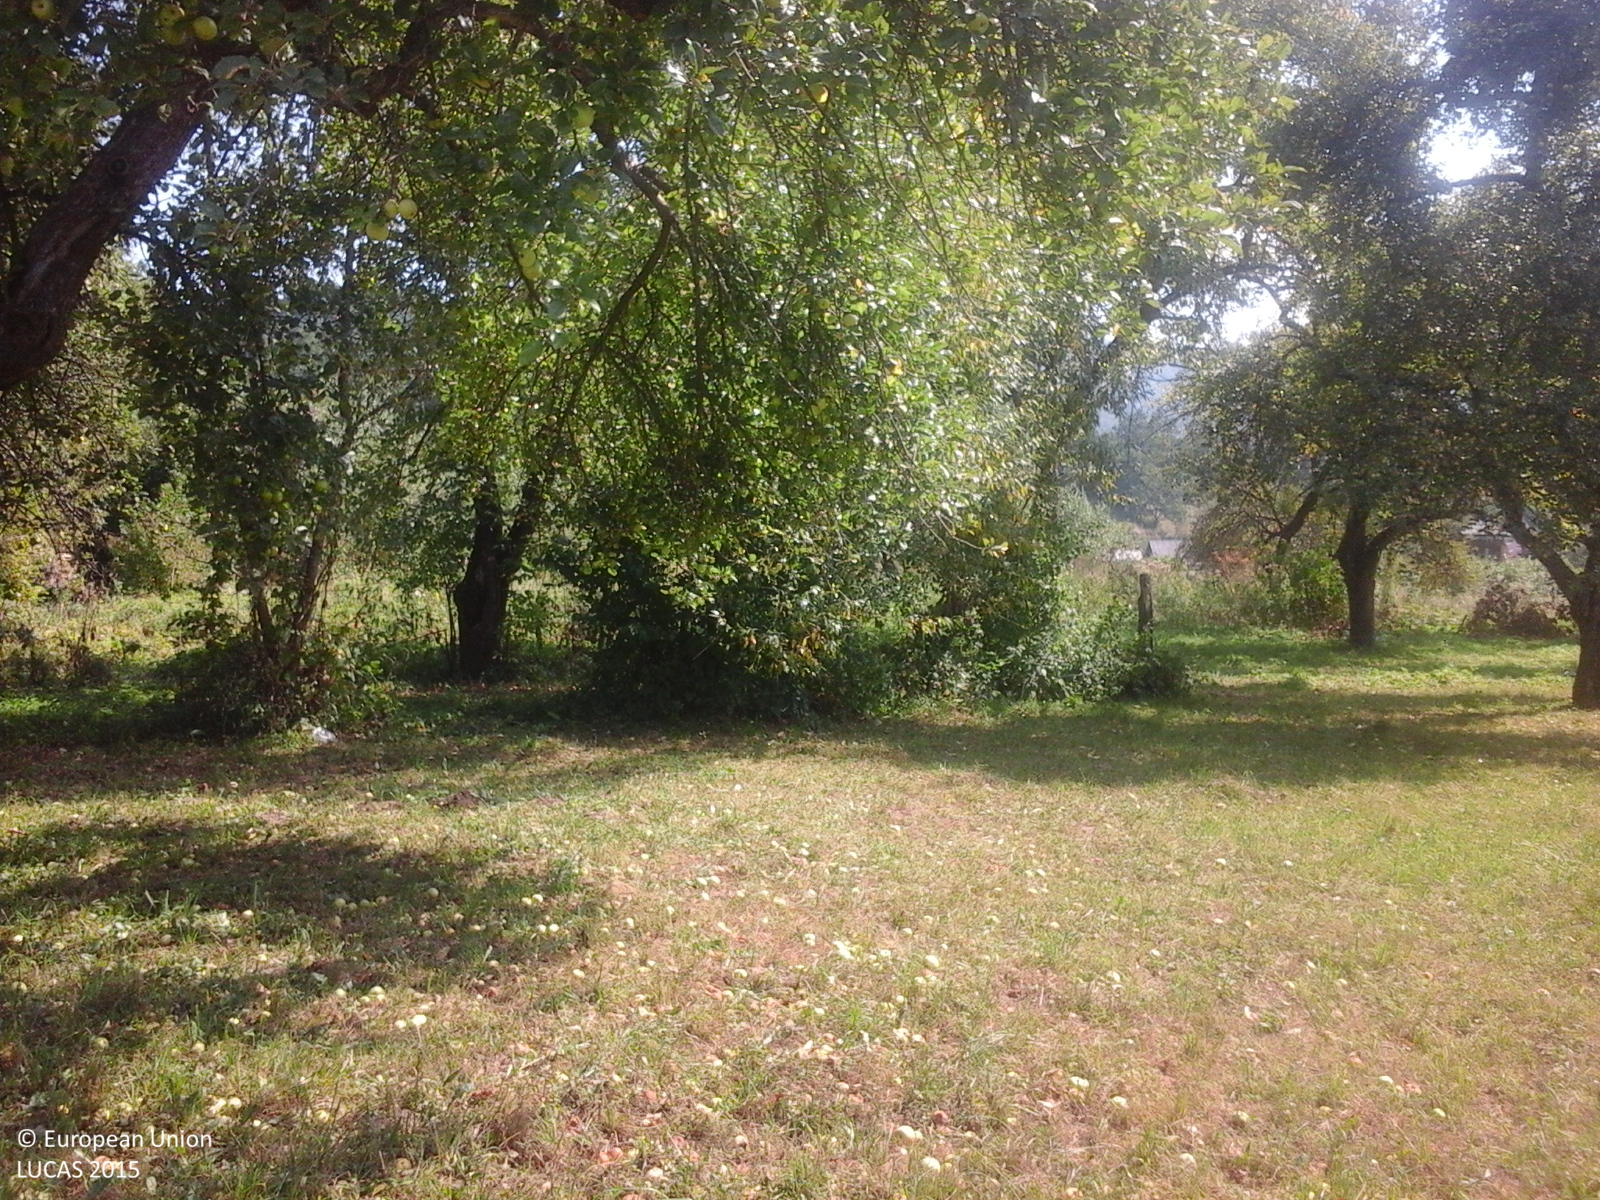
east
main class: Grassland
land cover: Grassland without tree/shrub cover
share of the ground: > 75 %
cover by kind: herbaceous plants 100 %
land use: Agriculture (excluding fallow land and kitchen gardens)
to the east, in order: Grassland without tree/shrub cover; Abandoned hedges; Spontaneously vegetated surfaces; Abandoned hedges; Grassland without tree/shrub cover; Ditches and canals; Spontaneously vegetated surfaces; Sand; Fences; Grass margins; Paved roads, cycling and walking lanes; Grass margins; Ditches and canals; Grass margins; Artificial constructions in urban areas; Apple fruit
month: September
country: RO
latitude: 47.7814
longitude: 24.2779
